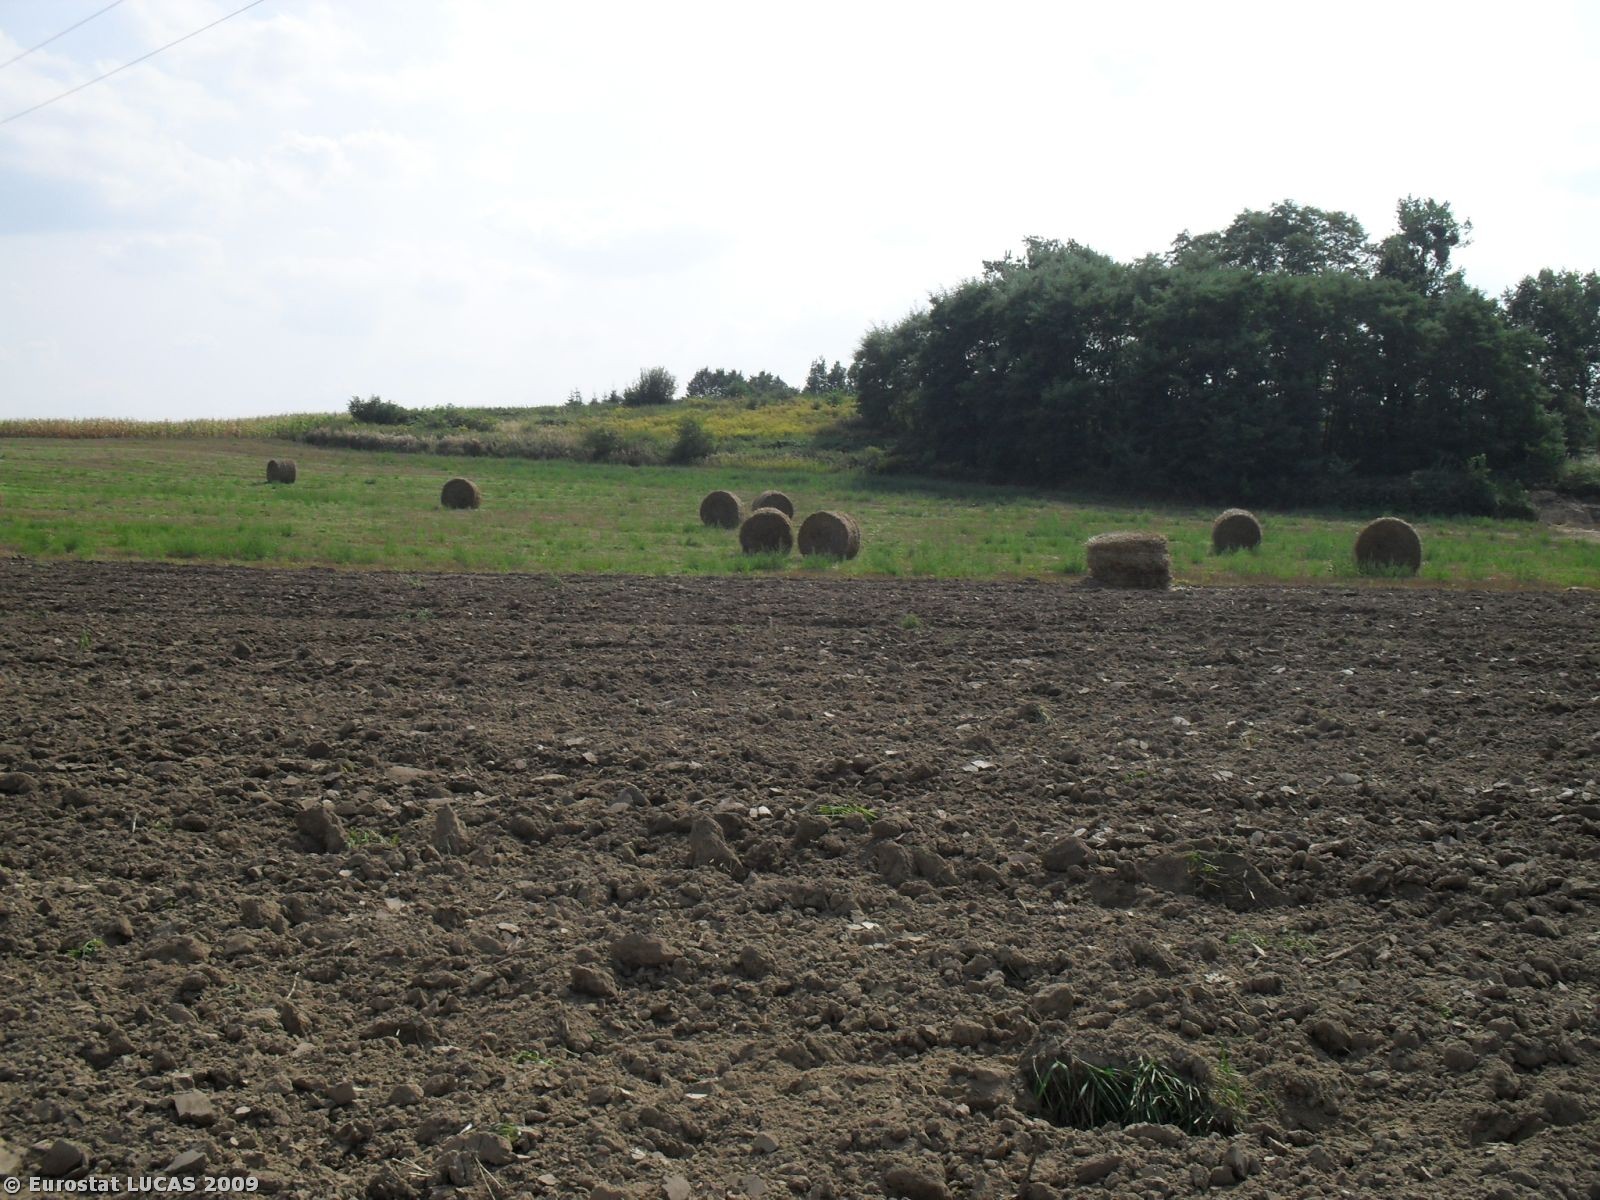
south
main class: Cropland
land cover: Common wheat
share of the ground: < 10 %
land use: Agriculture (excluding fallow land and kitchen gardens)
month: September
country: PL
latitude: 50.5633
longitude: 17.3102
